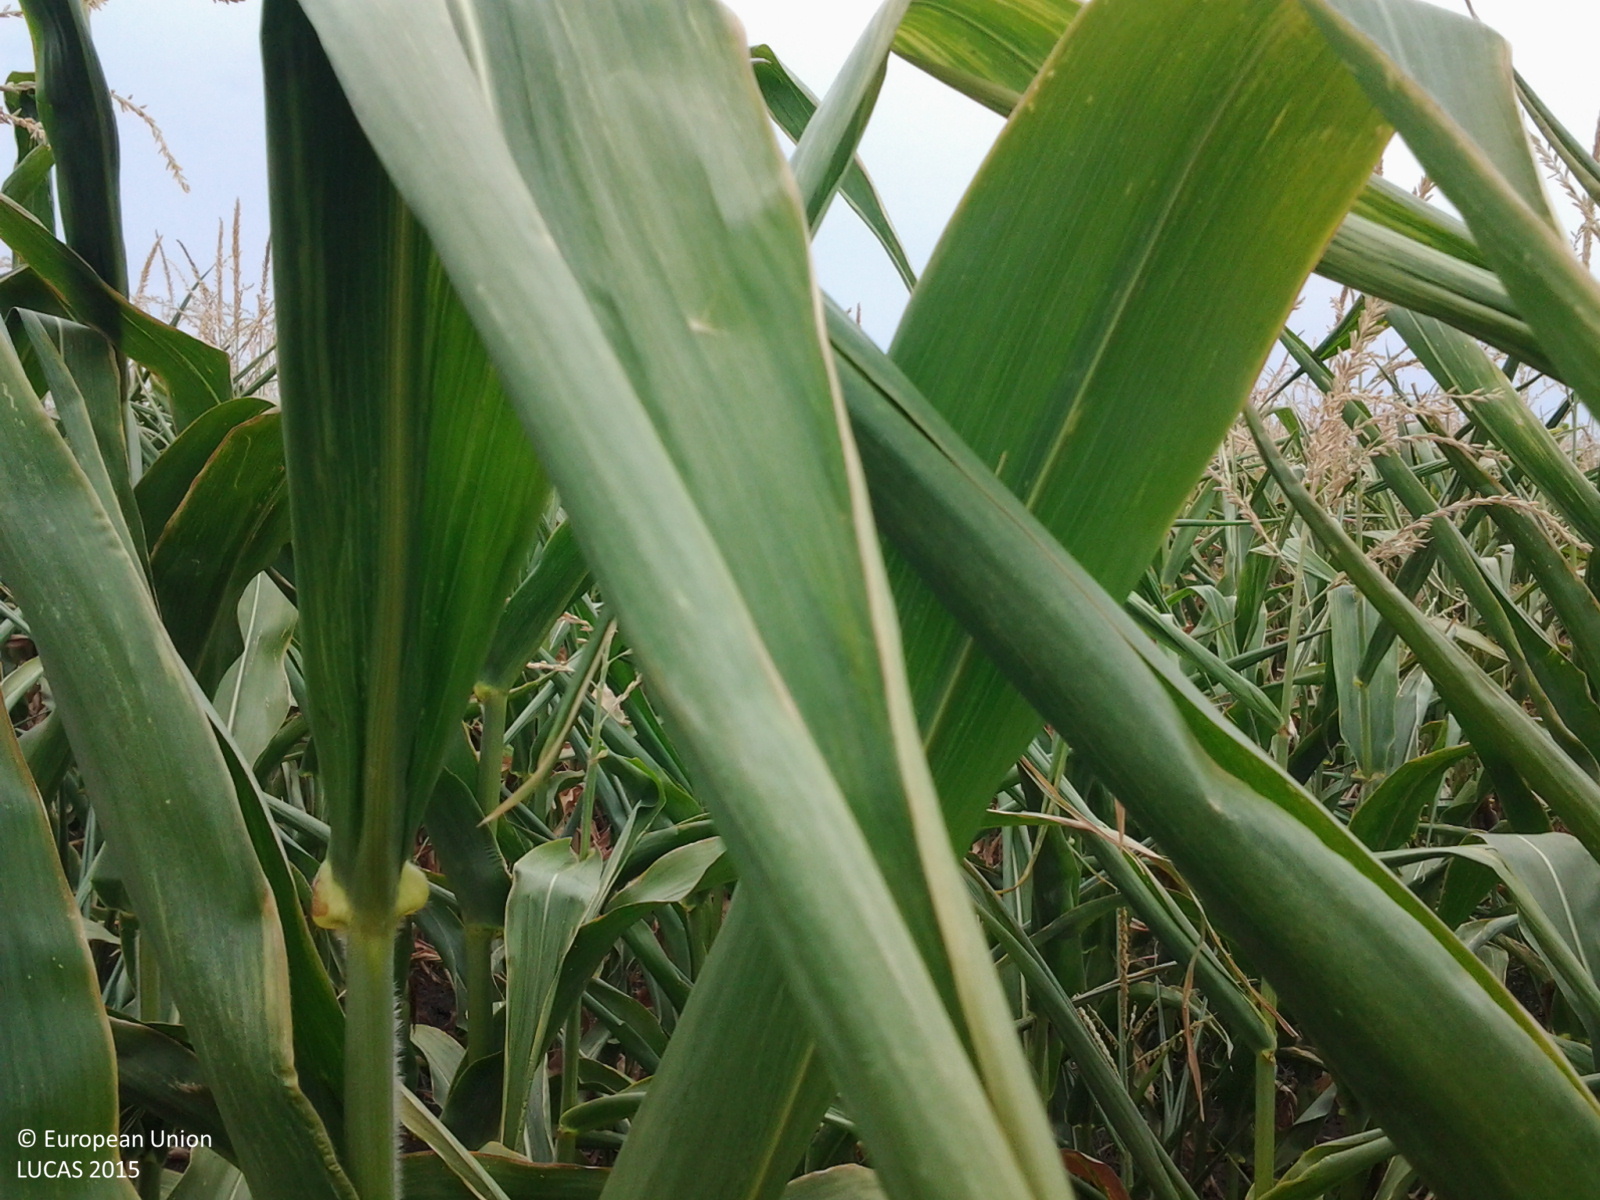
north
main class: Cropland
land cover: Maize
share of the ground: > 75 %
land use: Agriculture (excluding fallow land and kitchen gardens)
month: July
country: HU
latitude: 47.2634
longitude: 20.5372
